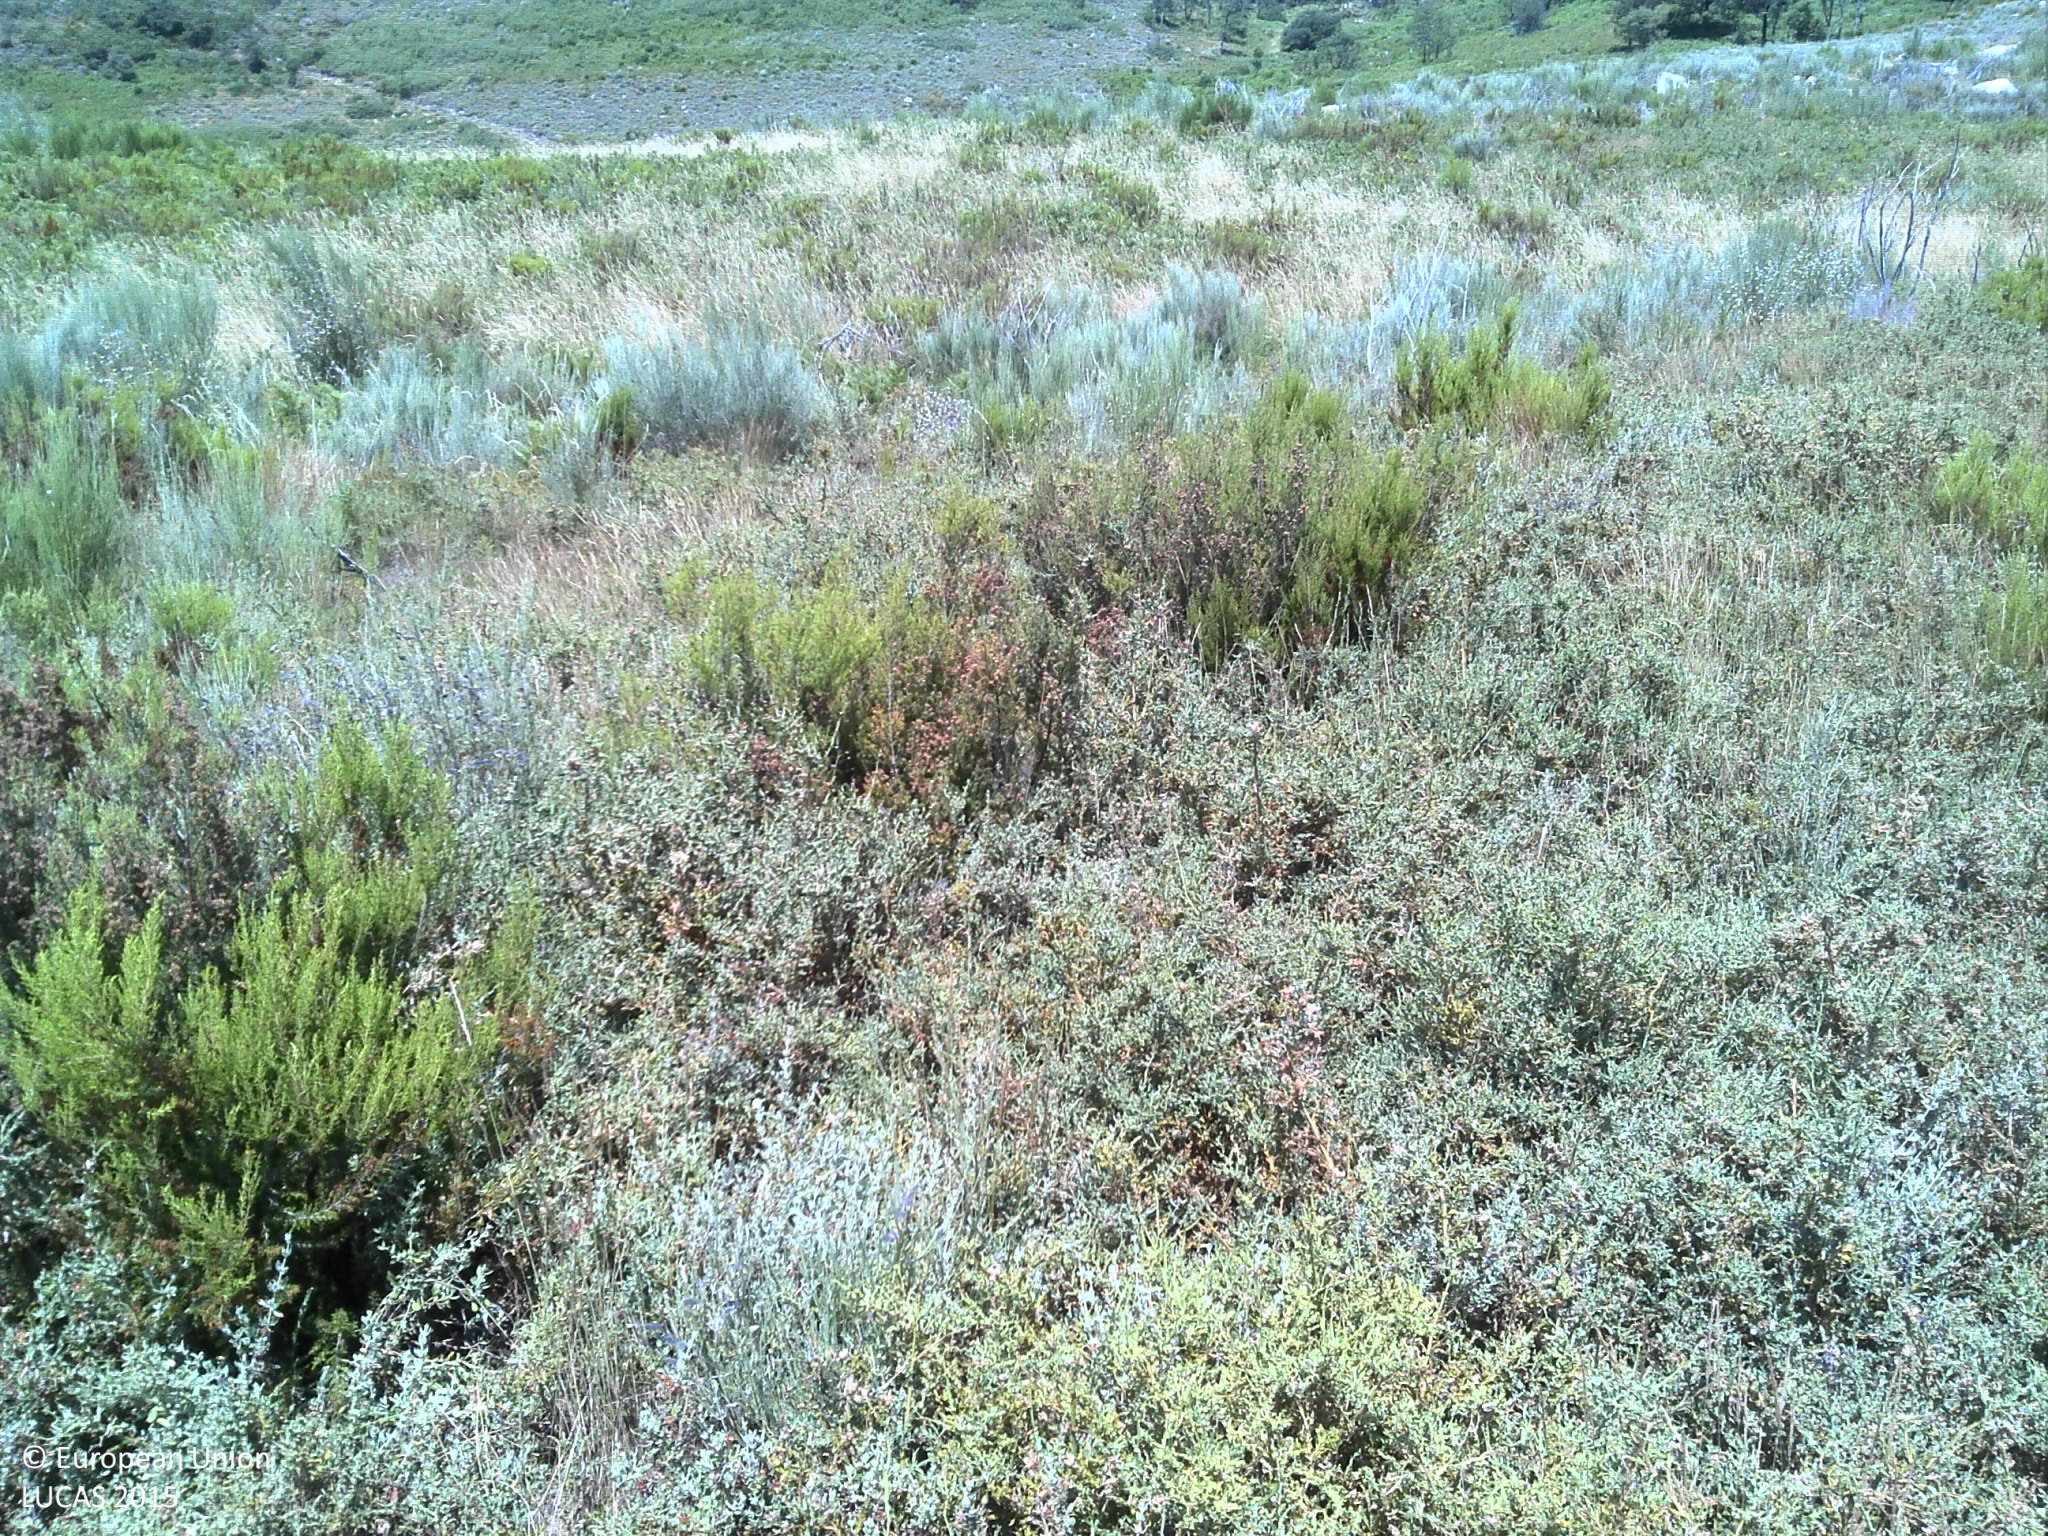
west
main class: Shrubland
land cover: Shrubland without tree cover
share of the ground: > 75 %
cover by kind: shrubs 90 %, herbaceous plants 10 %
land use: Semi-natural and natural areas not in use
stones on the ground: 10 - 25 %
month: July
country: PT
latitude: 41.8705
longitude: -7.7174
